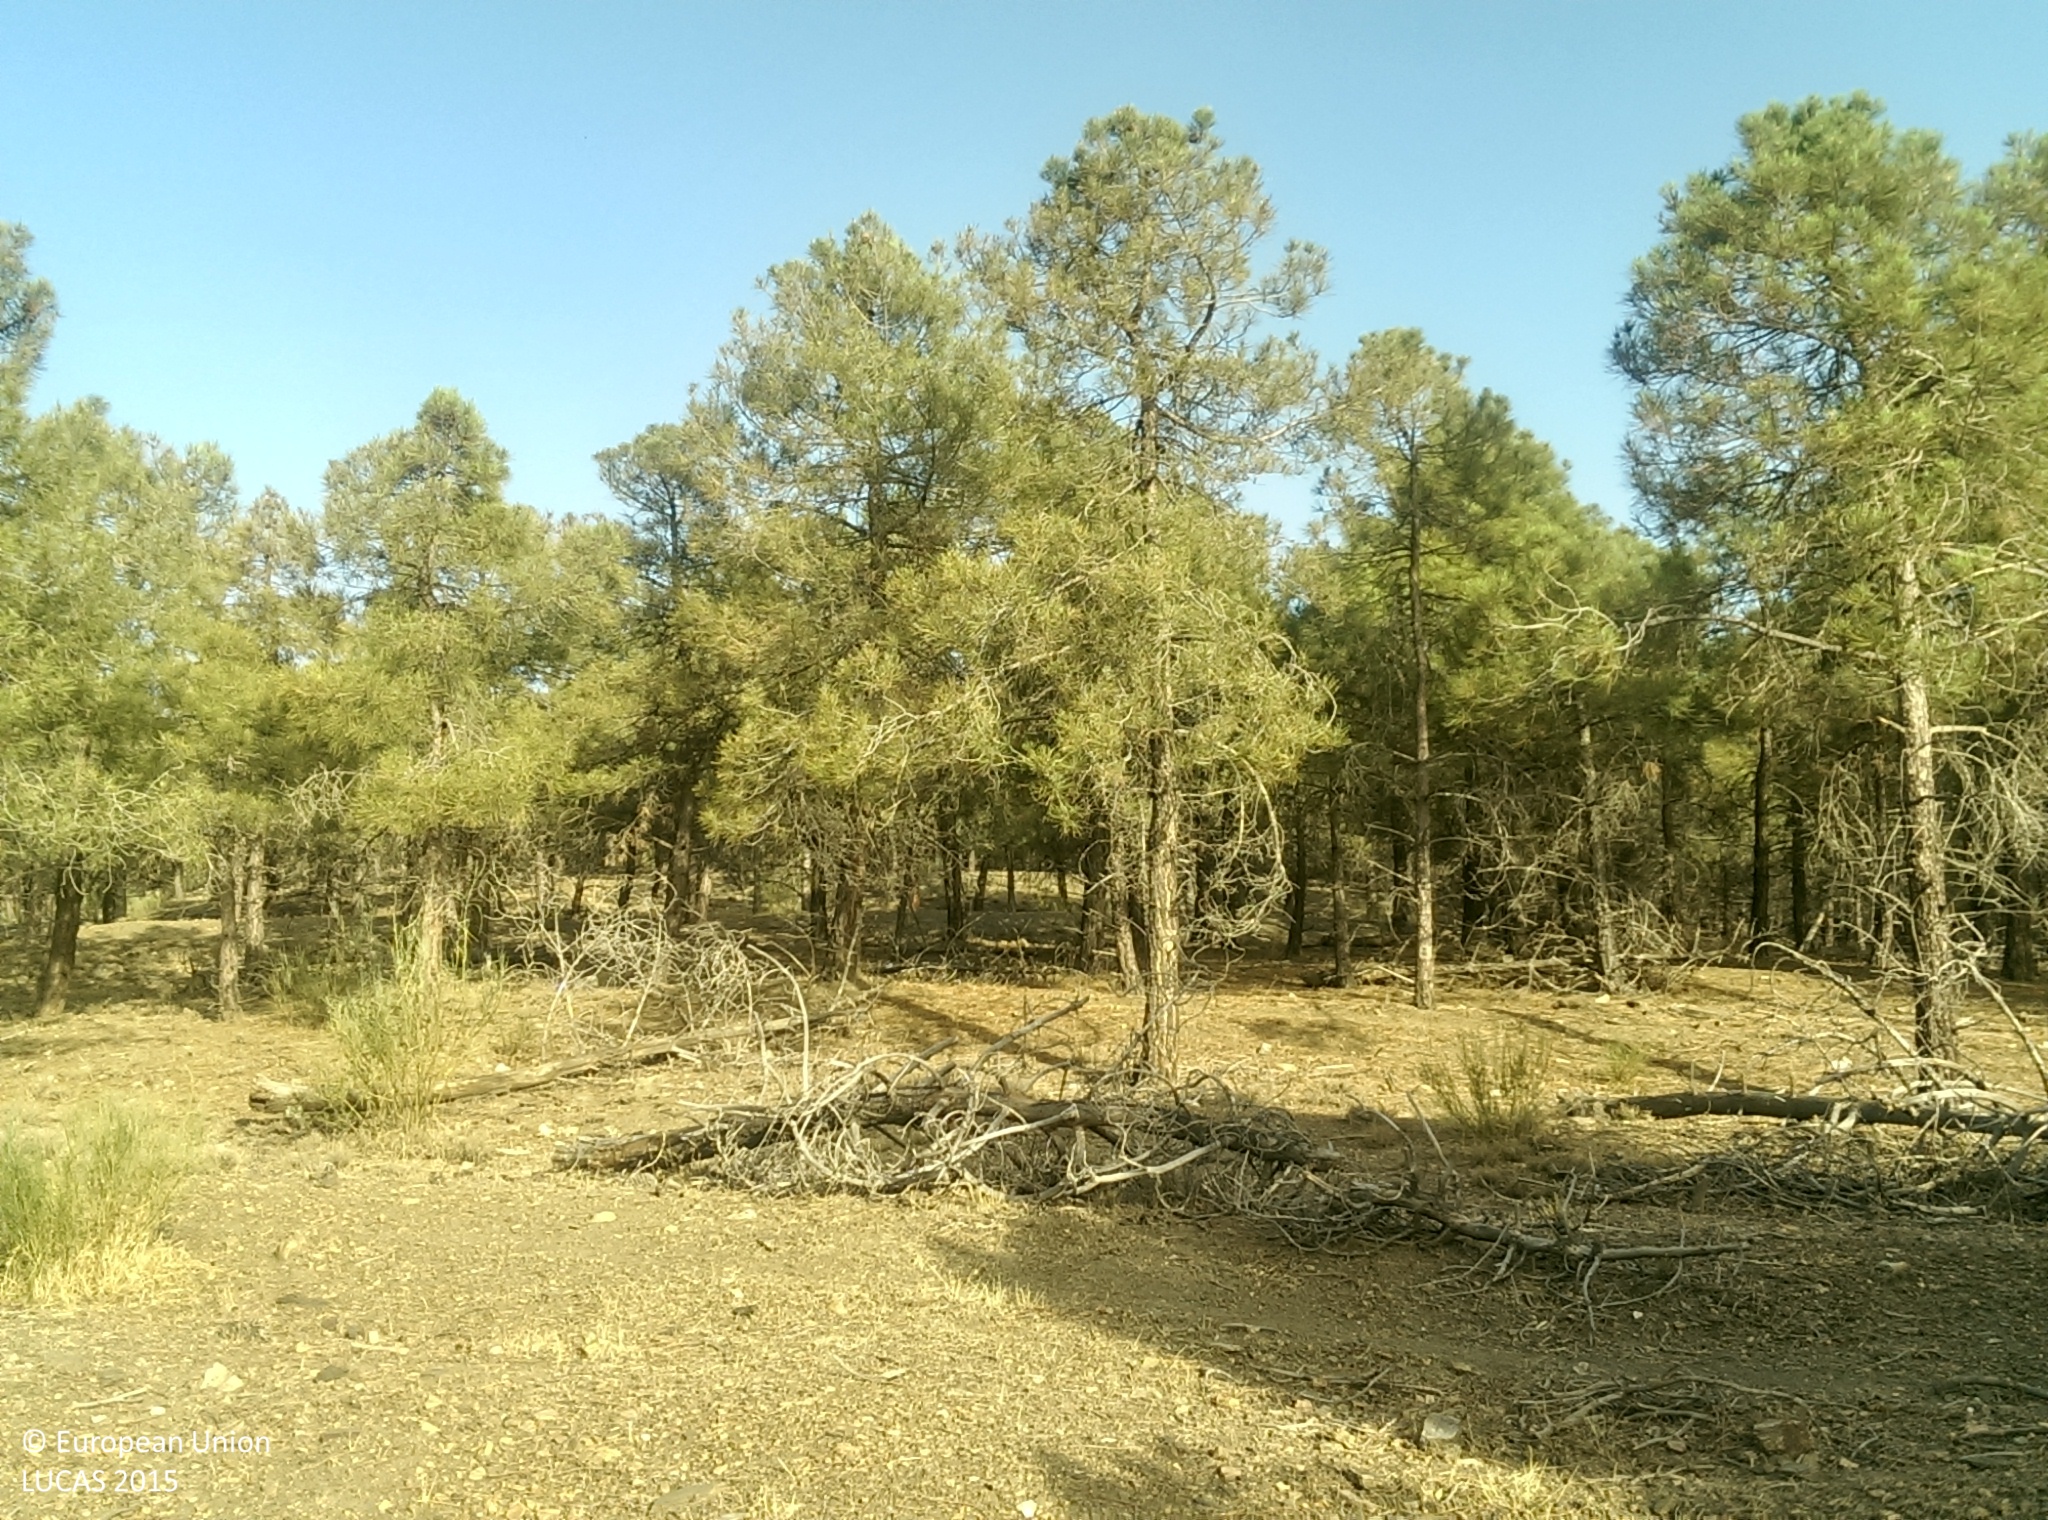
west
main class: Woodland
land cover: Pine dominated coniferous woodland
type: coniferous forest of the mediterranean region
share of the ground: 50 - 75 %
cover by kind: coniferous forest trees 55 %, lichens and mosses 20 %, unconsolidated bare surface 15 %, shrubs 10 %
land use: Forestry
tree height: > 5 m
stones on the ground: 25 - 50 %
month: July
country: ES
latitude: 37.1605
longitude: -3.1488
